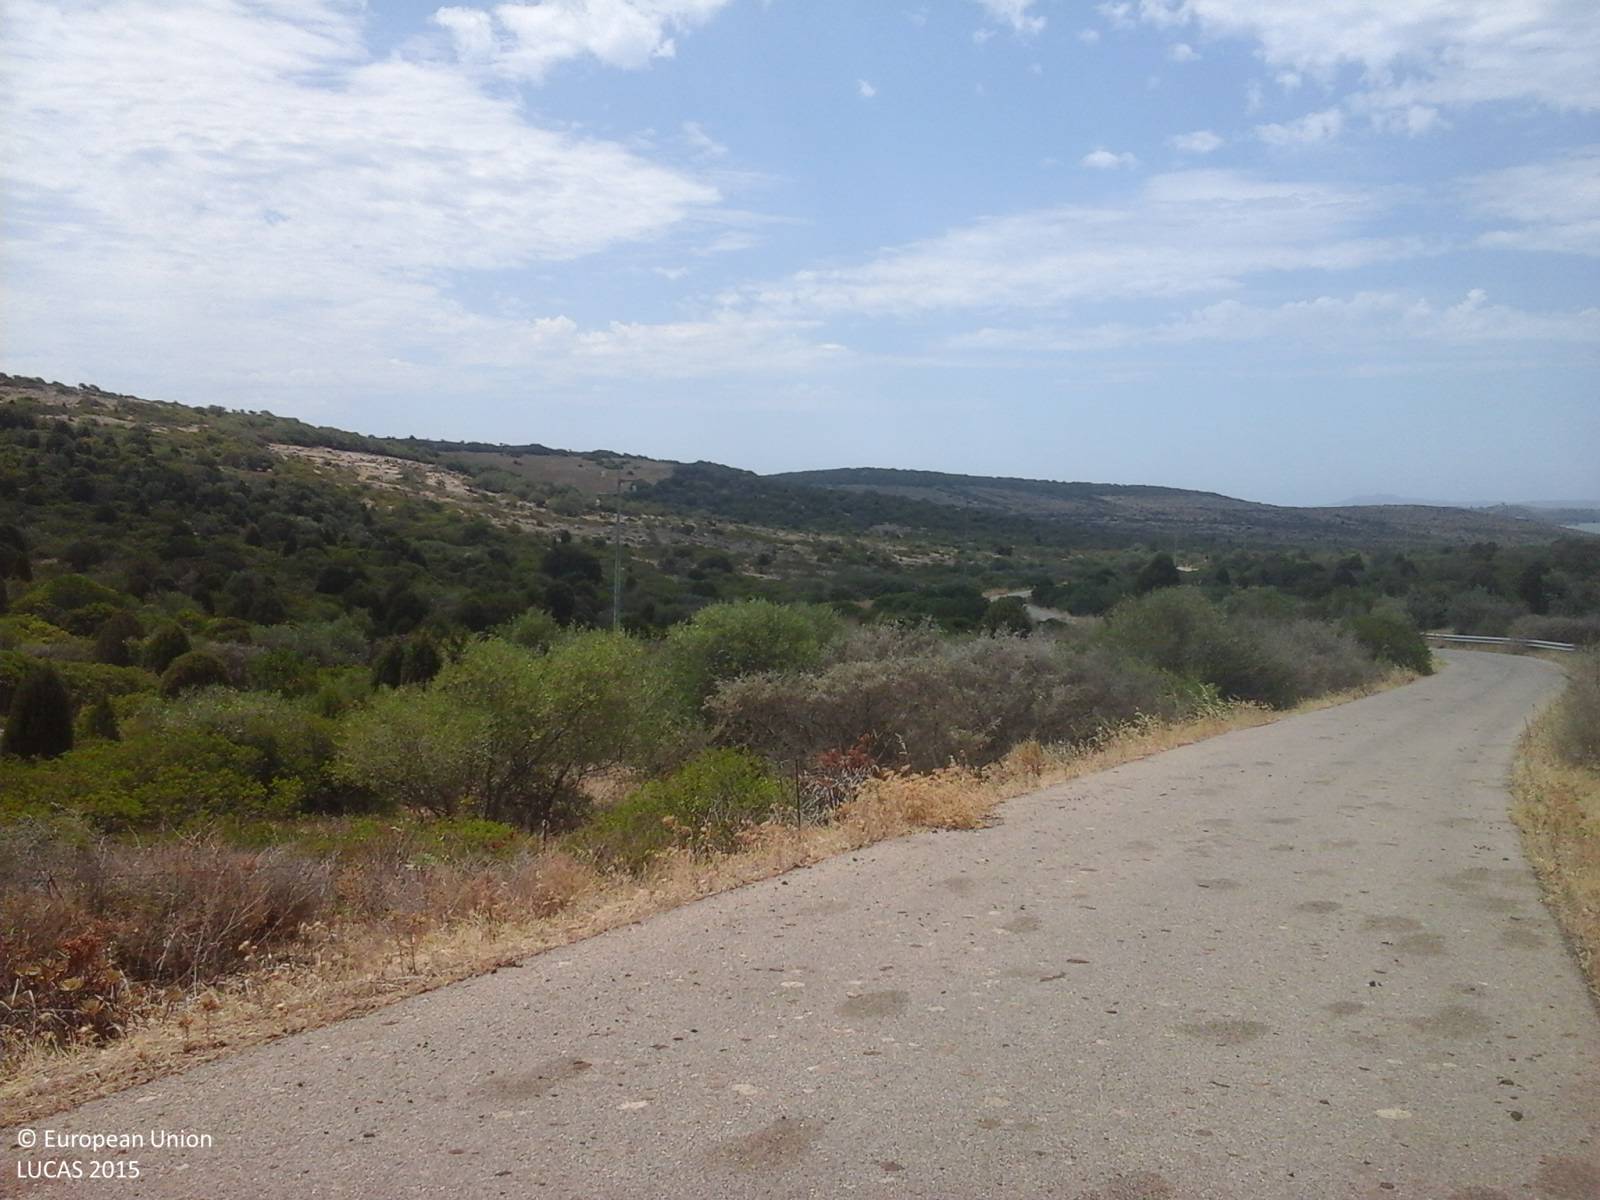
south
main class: Shrubland
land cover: Shrubland with sparse tree cover
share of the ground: > 75 %
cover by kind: shrubs 70 %, unconsolidated bare surface 20 %, broadleaved forest trees 5 %, herbaceous plants 5 %
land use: Agriculture (excluding fallow land and kitchen gardens)
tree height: < 5 m
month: July
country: IT
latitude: 39.1165
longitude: 8.6323
